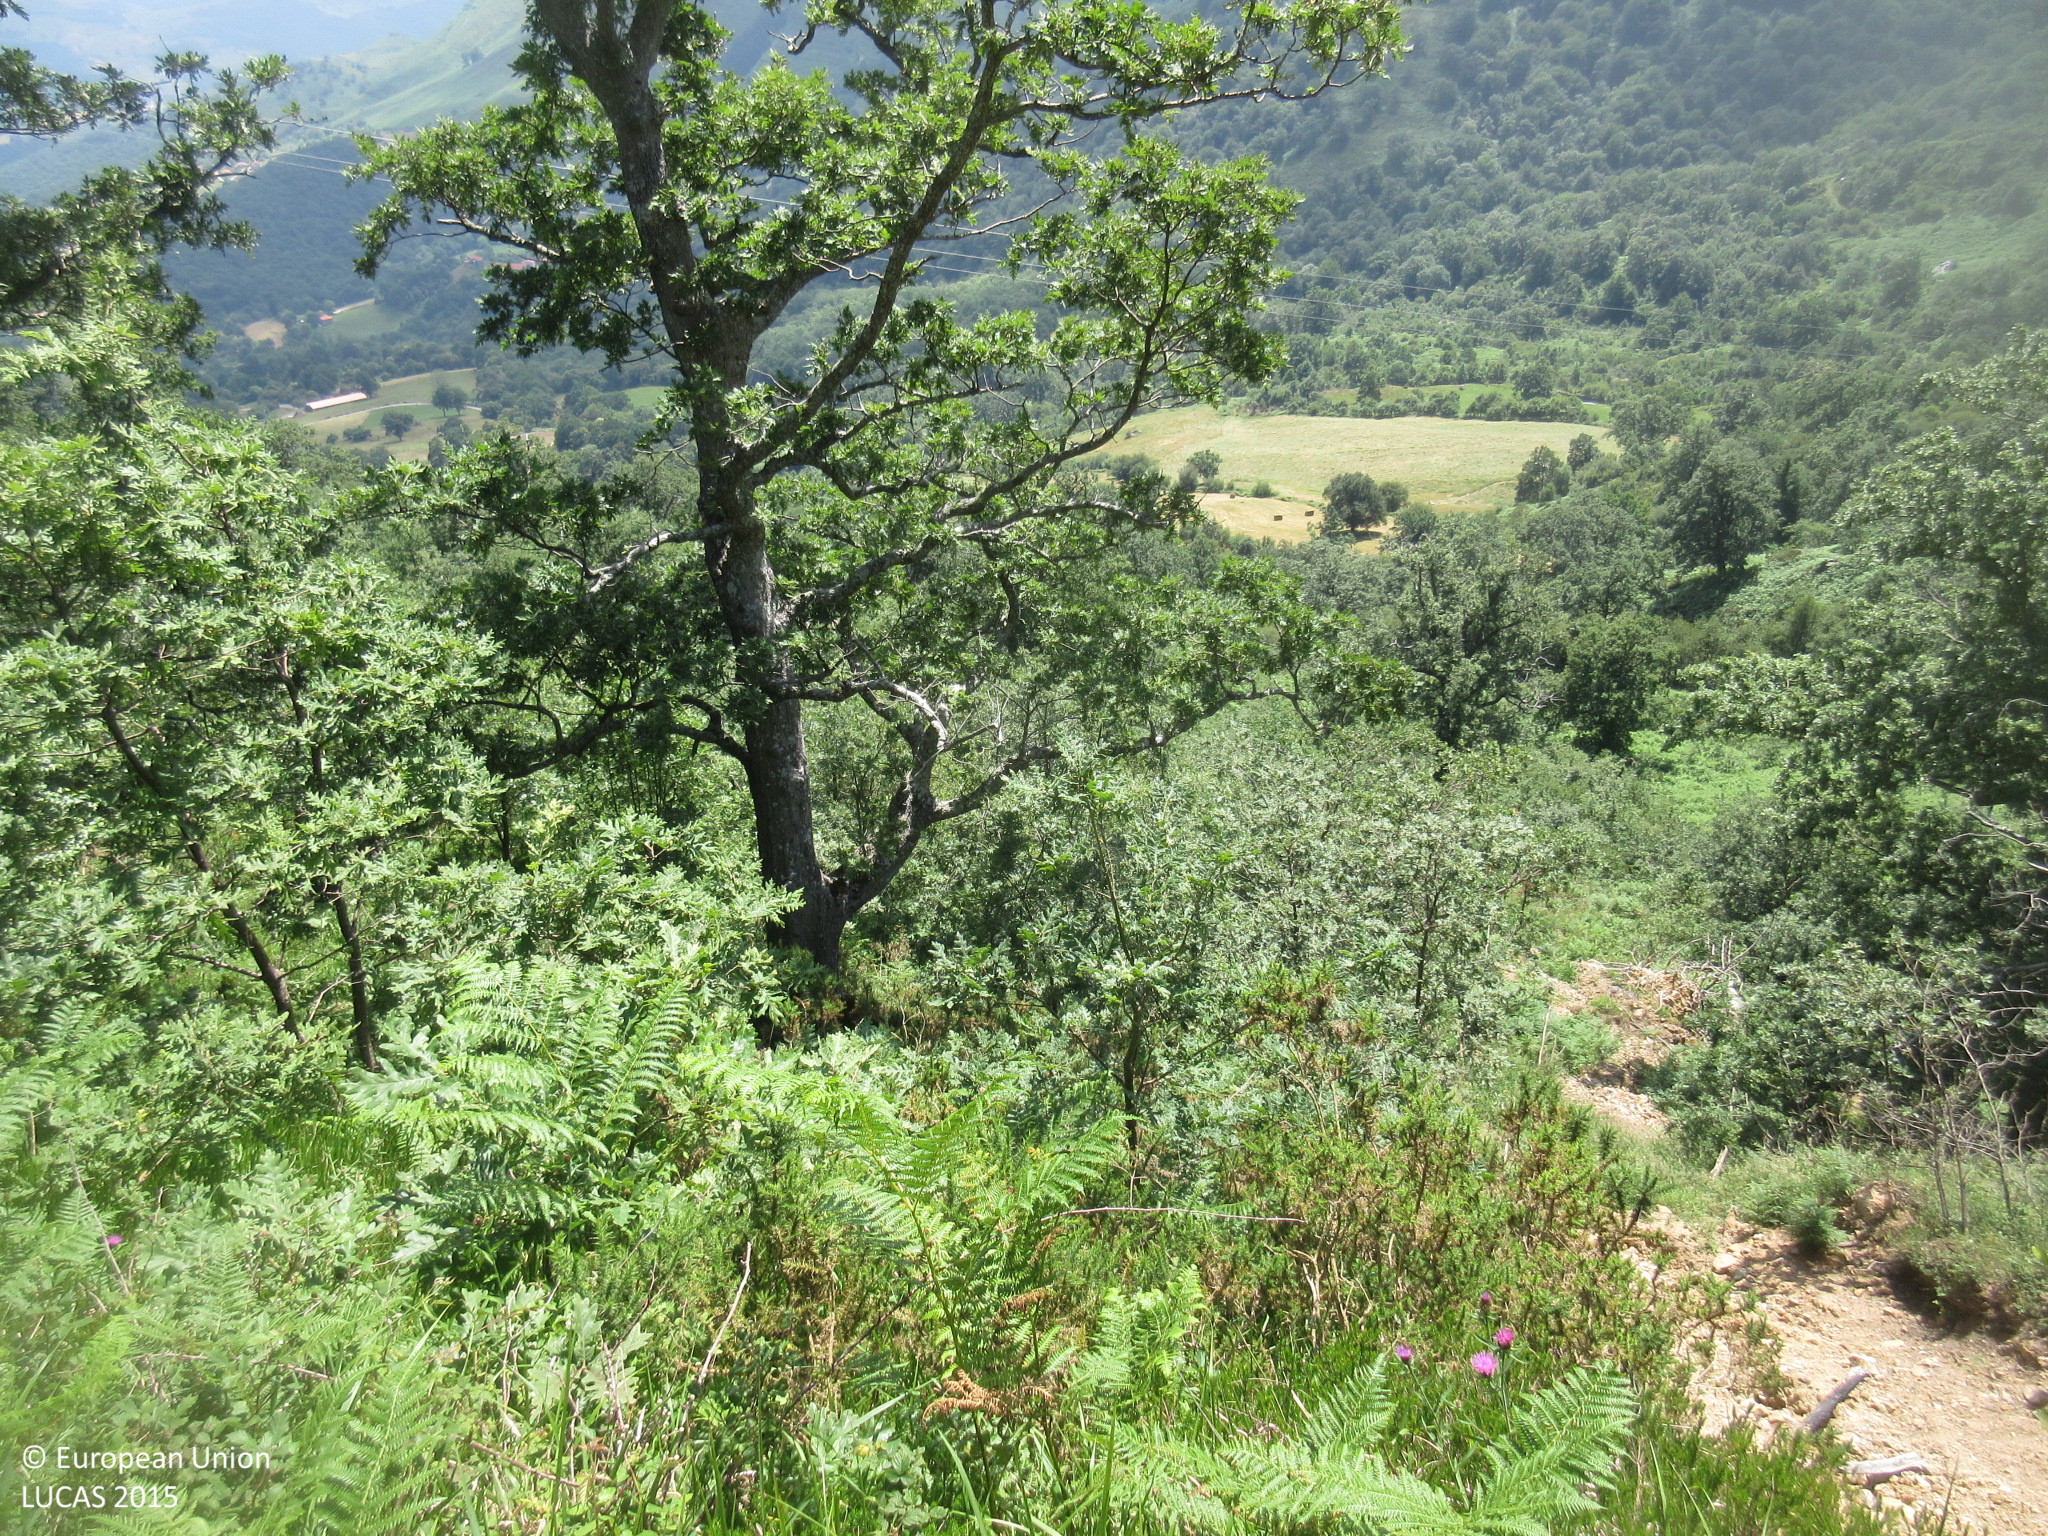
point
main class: Woodland
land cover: Broadleaved woodland
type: acidophilous oak and oak-birch forest
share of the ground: 25 - 50 %
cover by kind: shrubs 70 %, broadleaved forest trees 30 %
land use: Forestry
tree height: > 5 m
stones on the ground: < 10 %
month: July
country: ES
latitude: 43.1779
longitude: -3.5878
